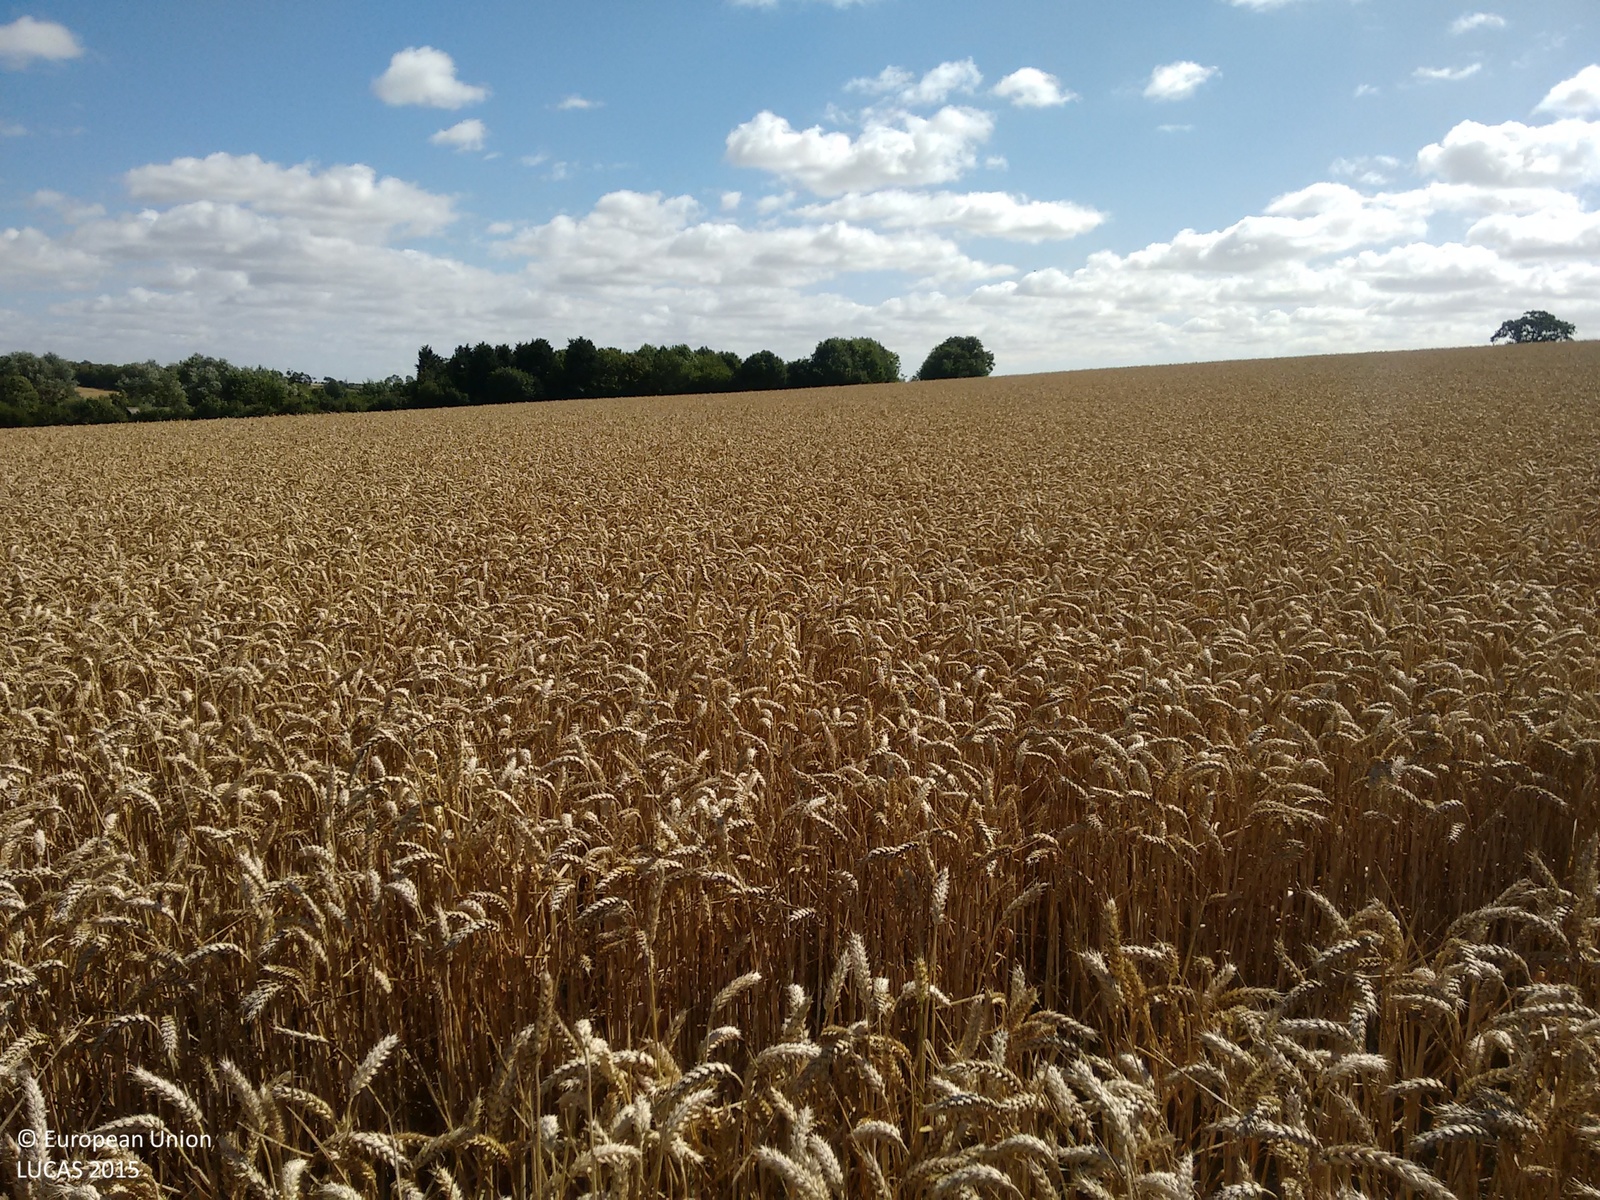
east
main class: Cropland
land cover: Common wheat
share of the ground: > 75 %
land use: Agriculture (excluding fallow land and kitchen gardens)
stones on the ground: 25 - 50 %
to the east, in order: Common wheat
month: August
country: GB
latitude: 52.0947
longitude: 0.3811
